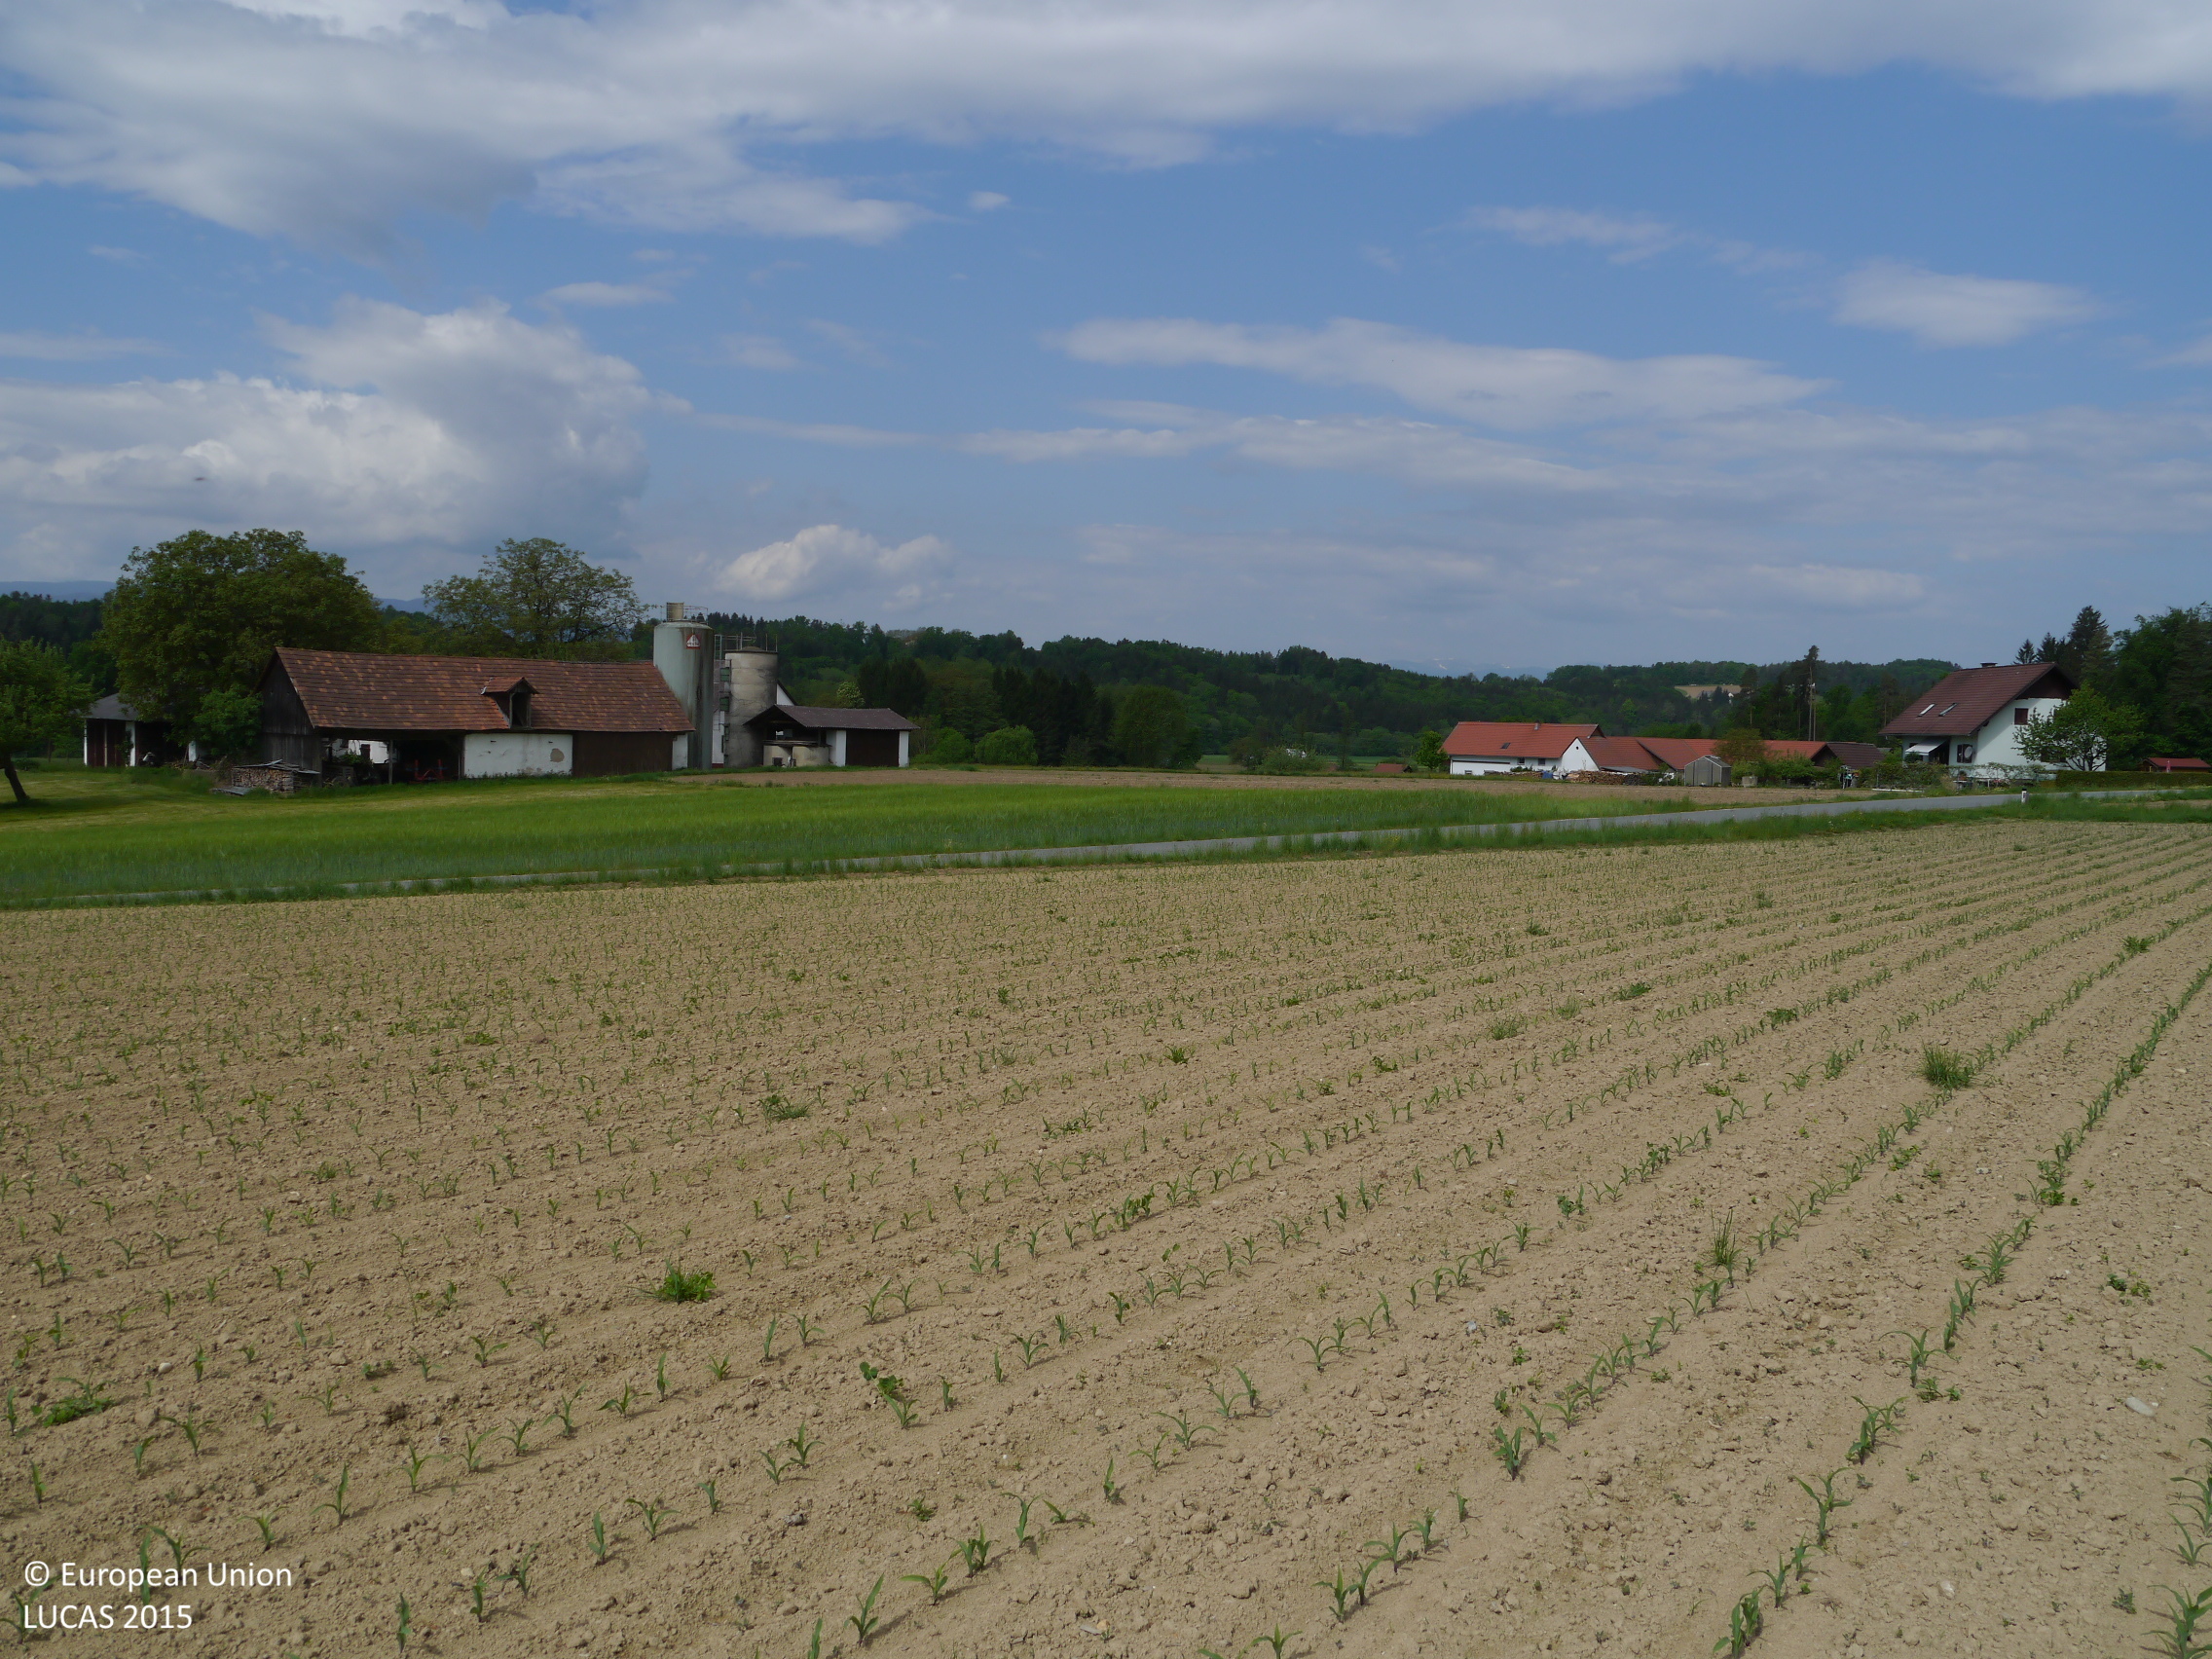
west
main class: Cropland
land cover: Maize
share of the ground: < 10 %
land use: Agriculture (excluding fallow land and kitchen gardens)
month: May
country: AT
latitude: 47.0125
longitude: 15.3270
